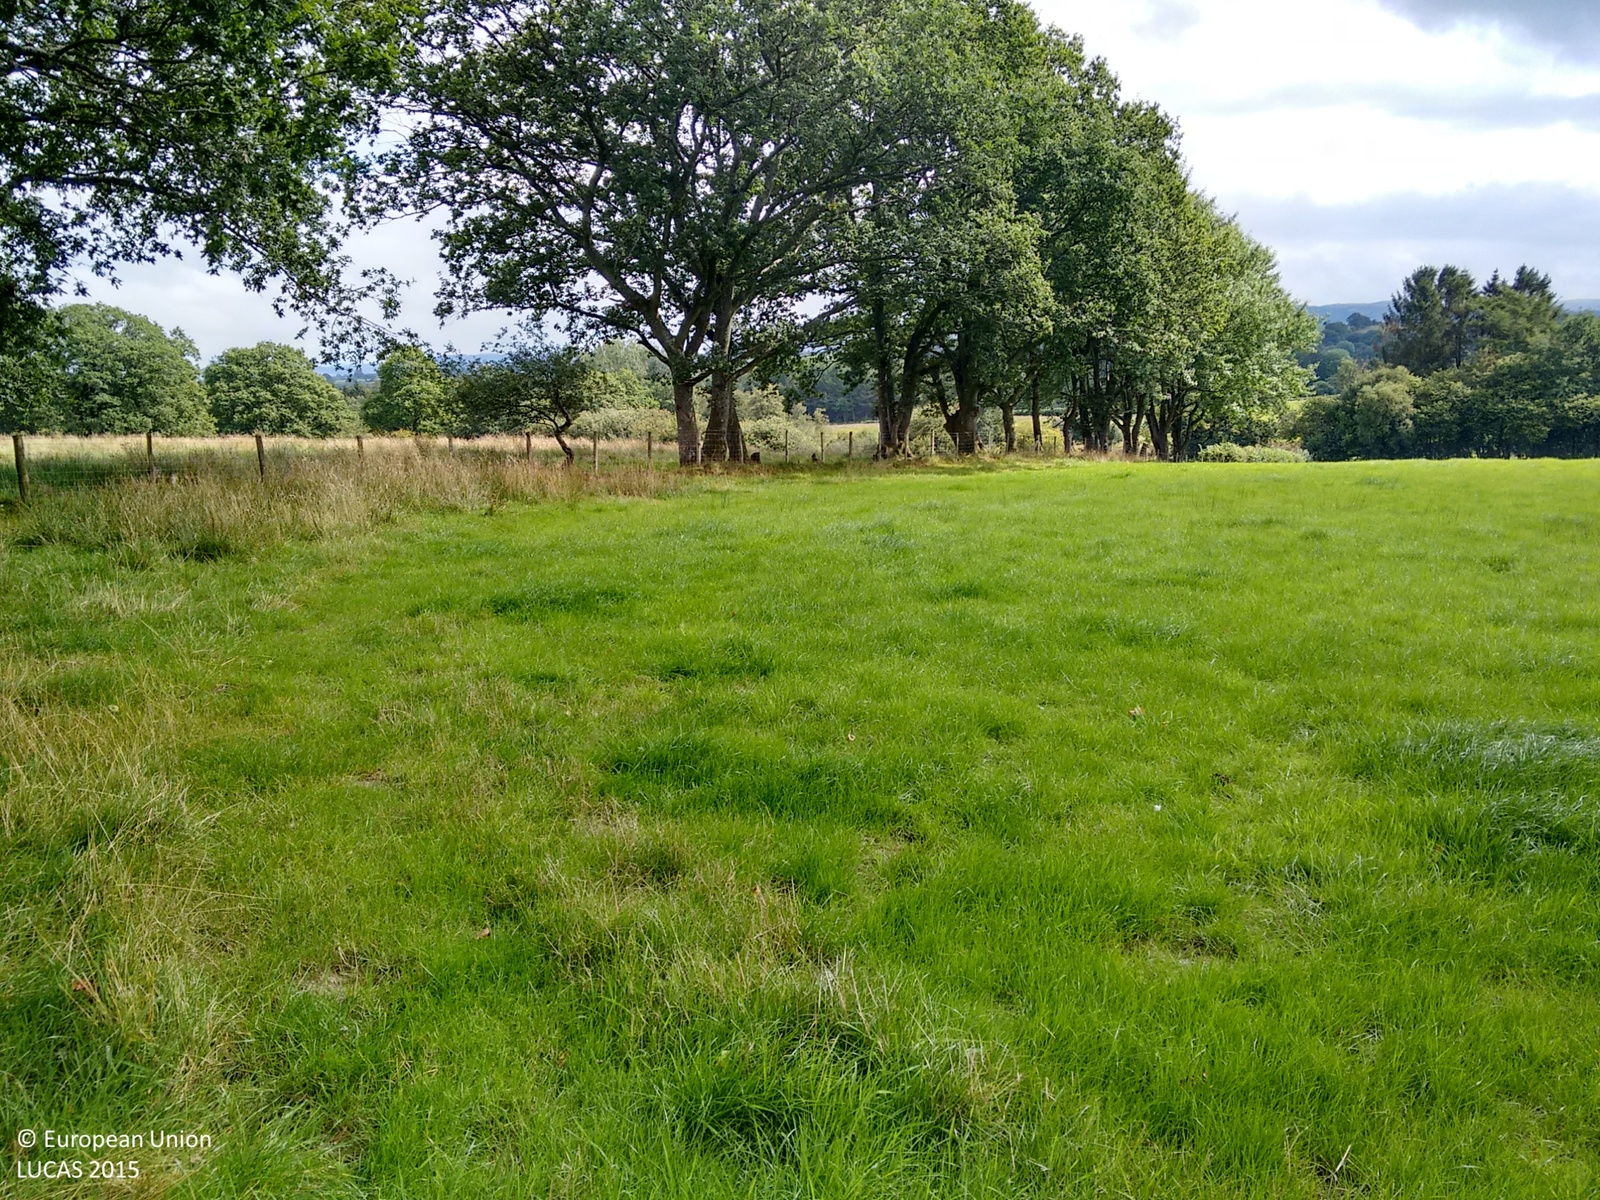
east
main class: Grassland
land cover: Grassland without tree/shrub cover
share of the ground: > 75 %
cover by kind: herbaceous plants 100 %
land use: Agriculture (excluding fallow land and kitchen gardens)
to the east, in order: Grassland without tree/shrub cover; Fences; Lines of trees; Grassland without tree/shrub cover; Fences; Abandoned hedges; Grassland without tree/shrub cover; Single bushes/trees; Ditches and canals; Grassland without tree/shrub cover
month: September
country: GB
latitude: 52.1890
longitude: -3.4681
